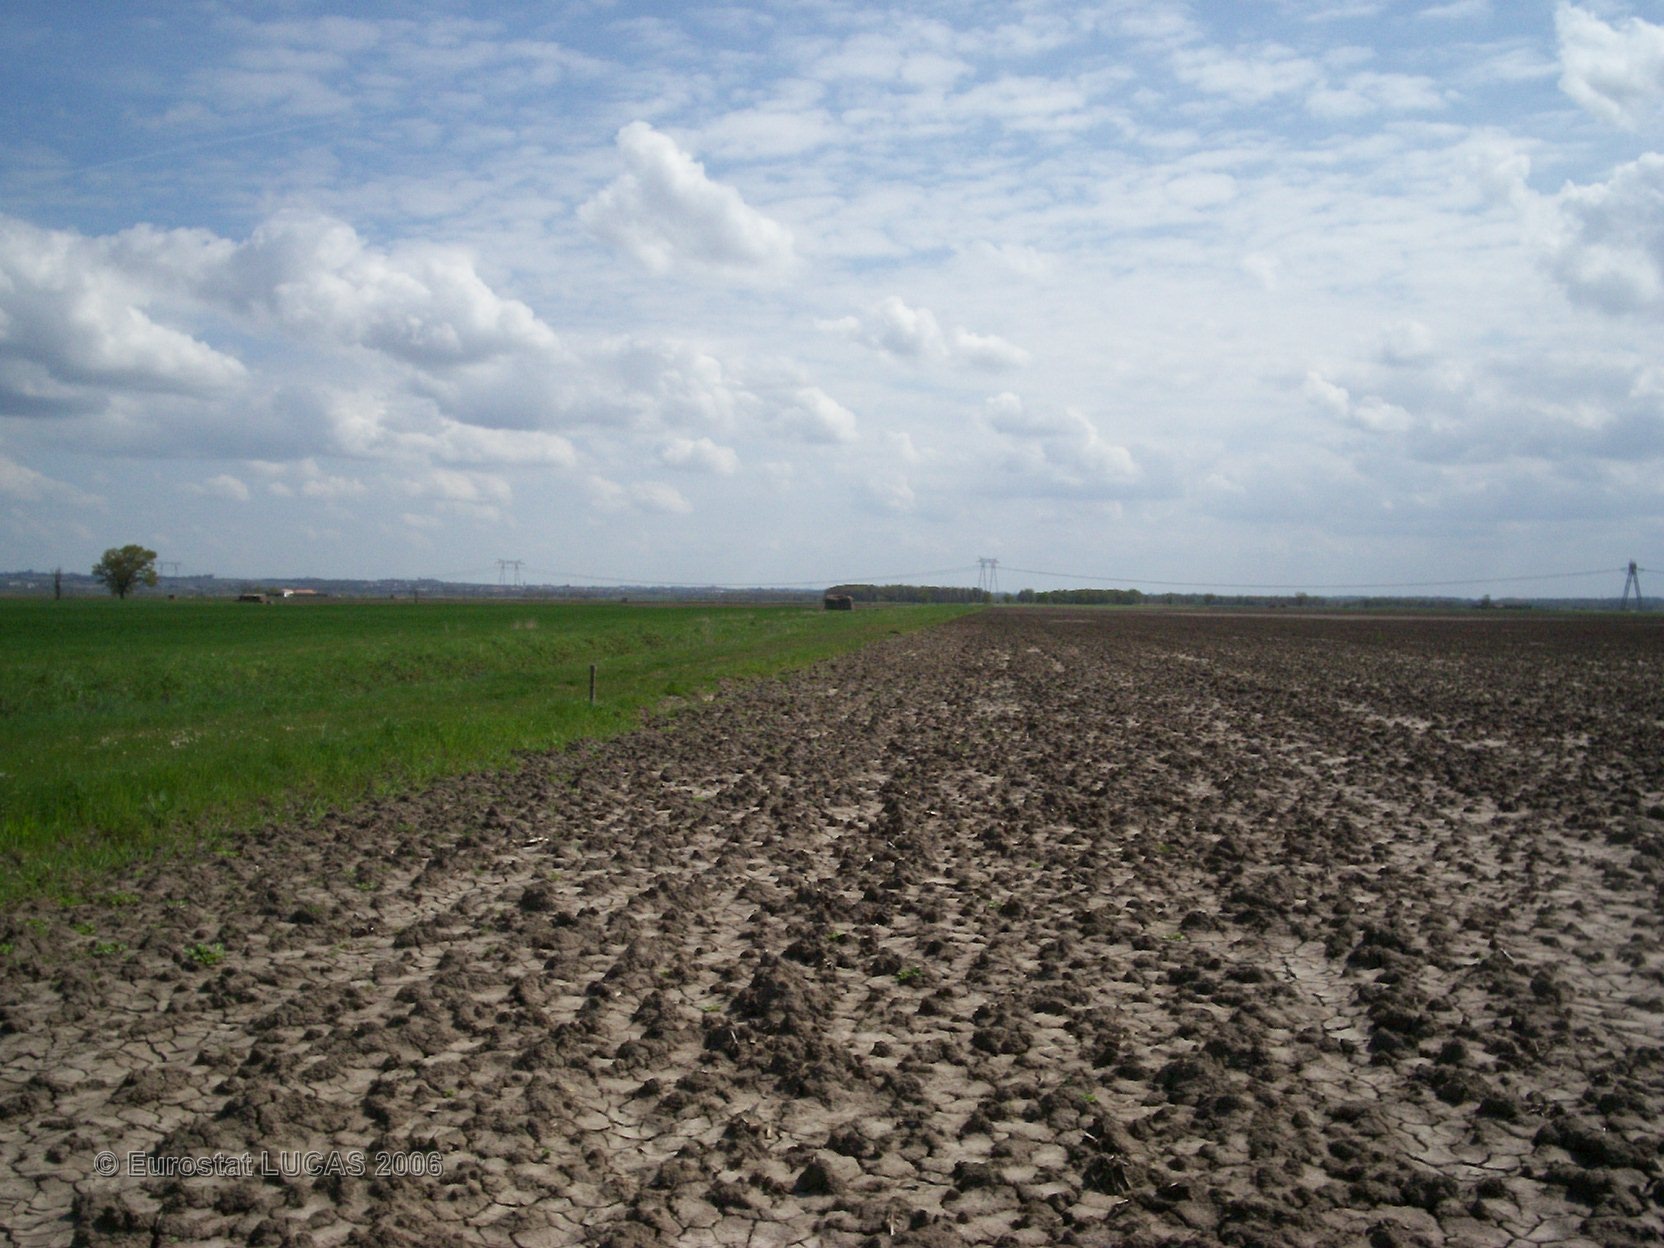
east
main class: Cropland
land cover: Maize
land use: Agriculture (excluding fallow land and kitchen gardens)
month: June
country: FR
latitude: 45.2689
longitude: -0.6902
